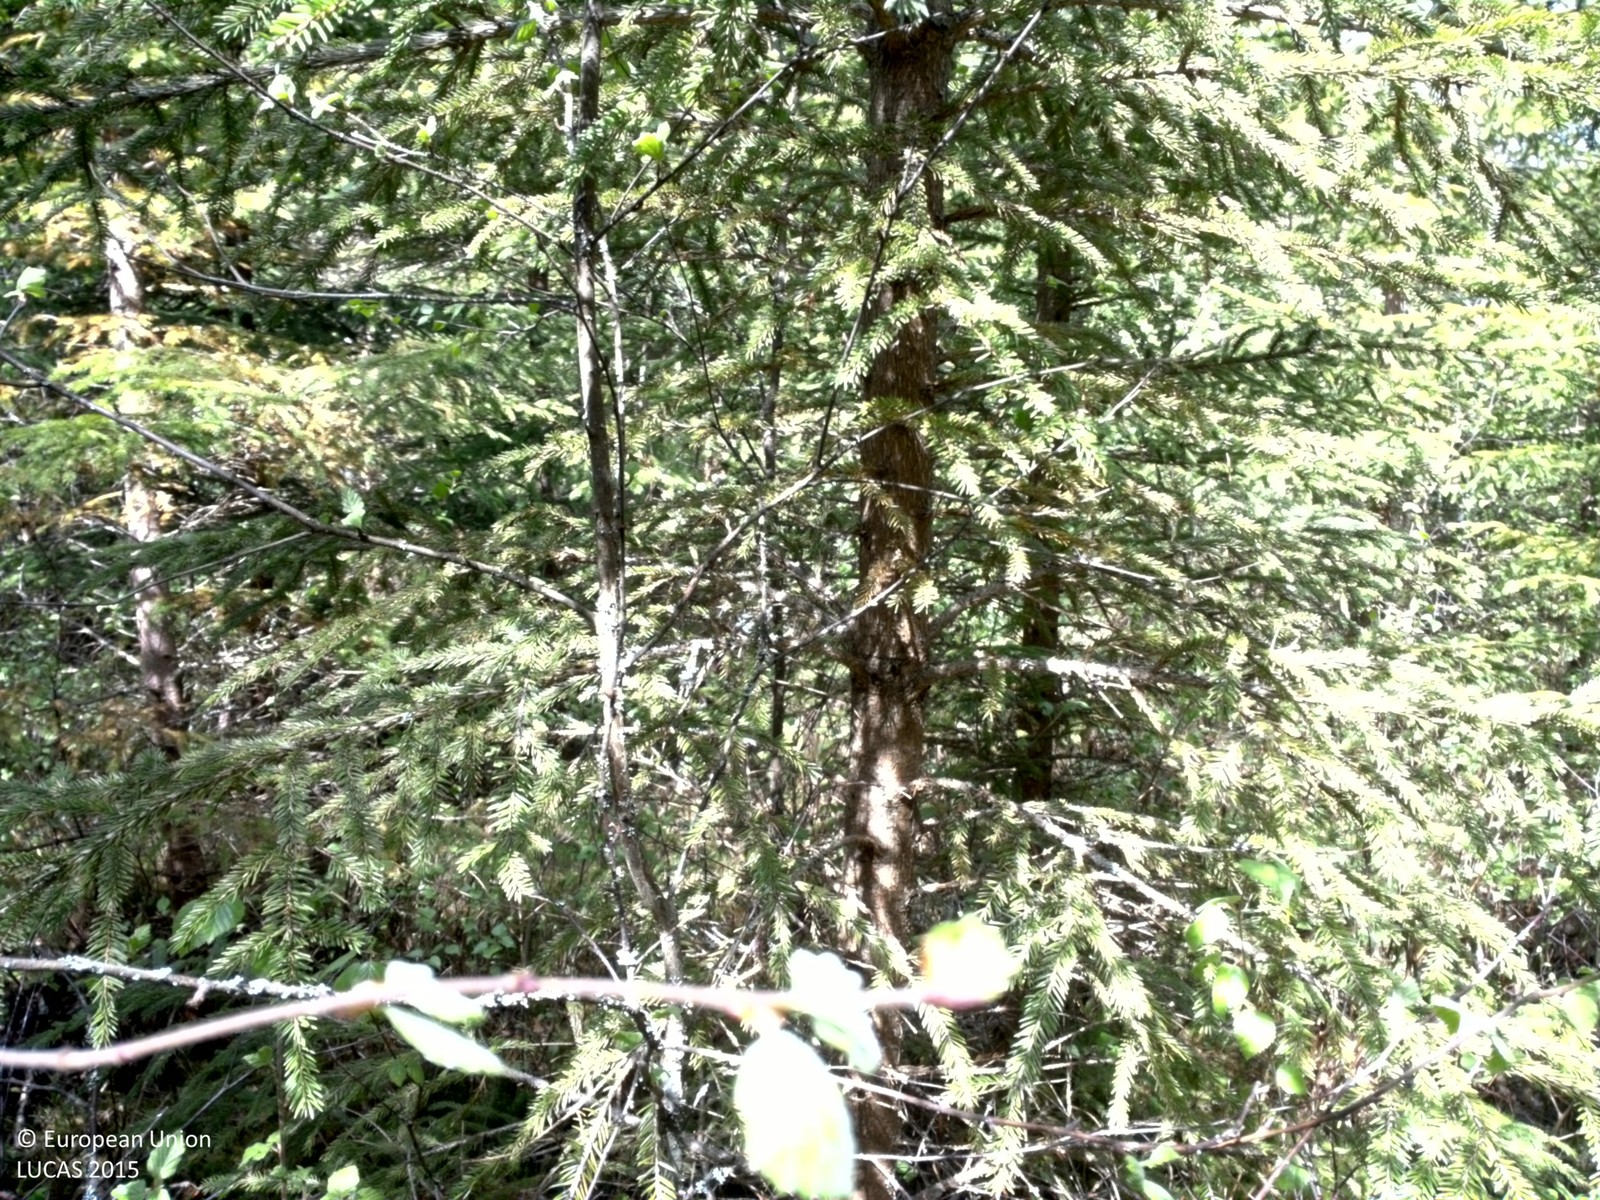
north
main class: Woodland
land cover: Spruce dominated mixed woodland
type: boreal forest
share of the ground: > 75 %
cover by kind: coniferous forest trees 75 %, broadleaved forest trees 25 %
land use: Forestry
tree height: < 5 m
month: May
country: SE
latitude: 56.5752
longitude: 15.4844
